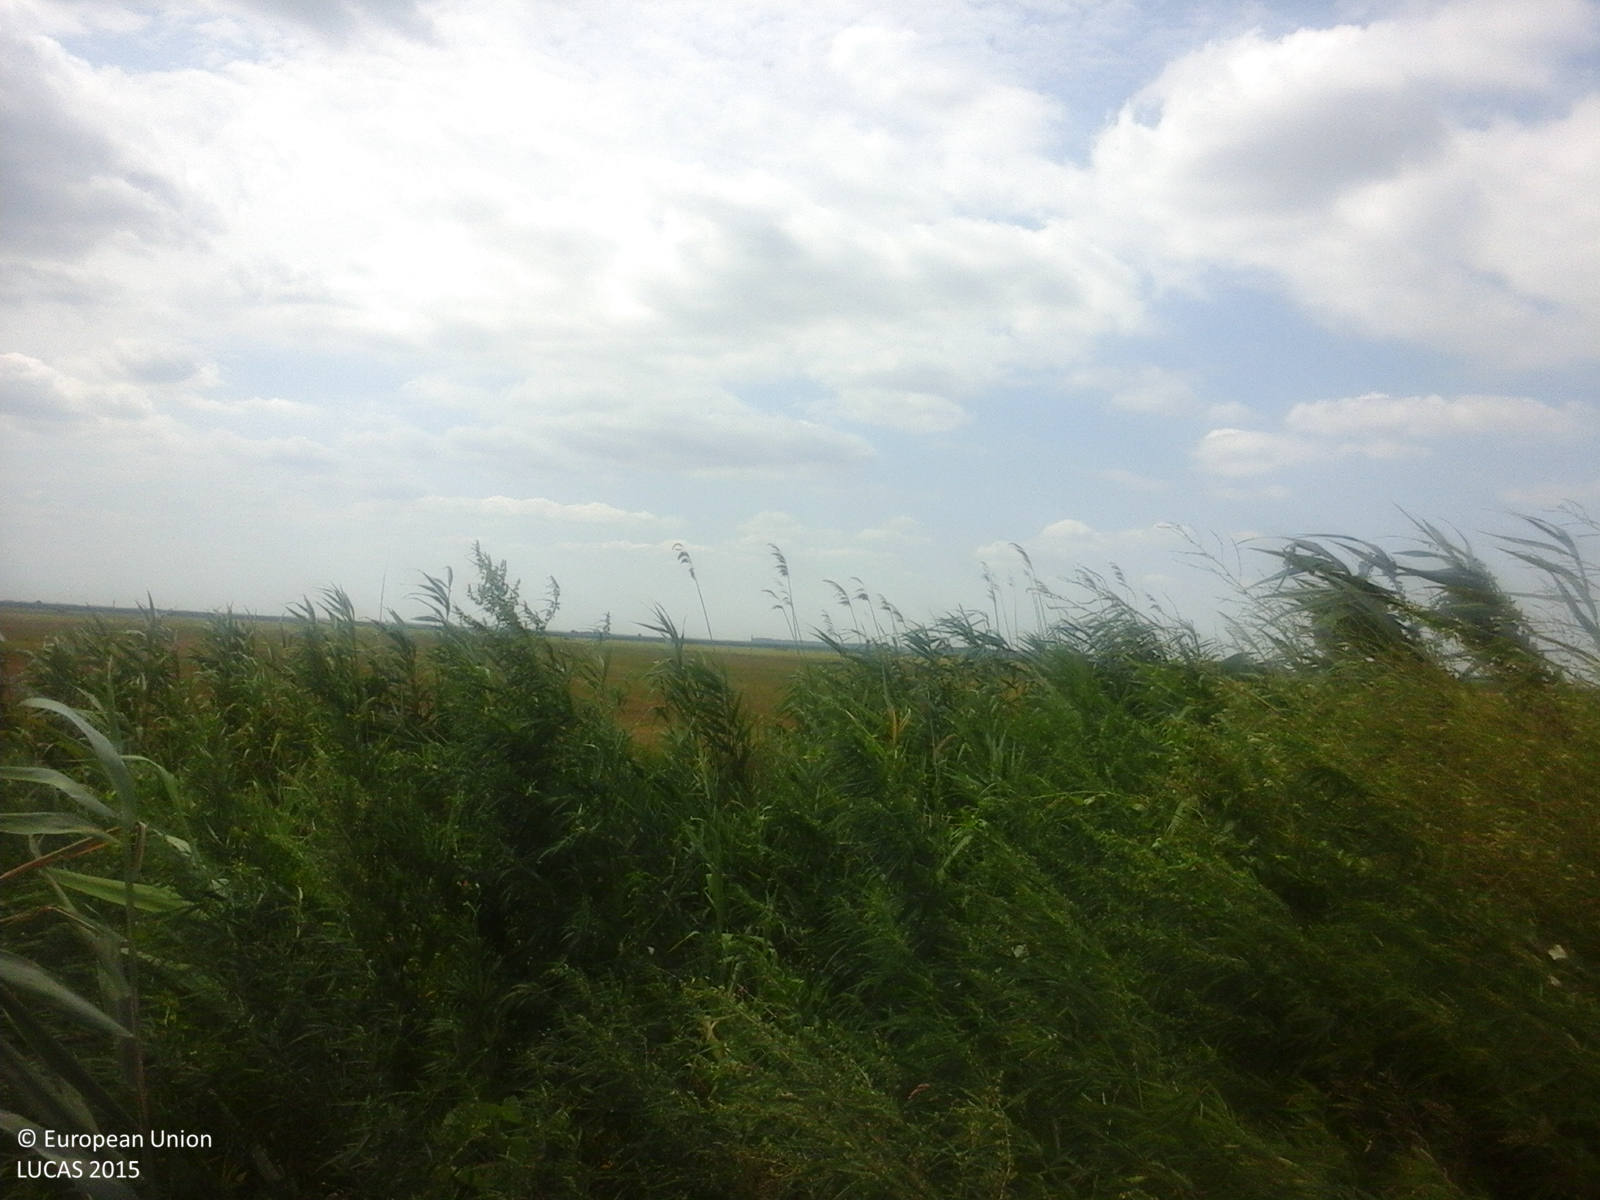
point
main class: Cropland
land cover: Barley
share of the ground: < 10 %
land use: Agriculture (excluding fallow land and kitchen gardens)
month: August
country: RO
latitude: 45.2907
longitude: 29.1130
